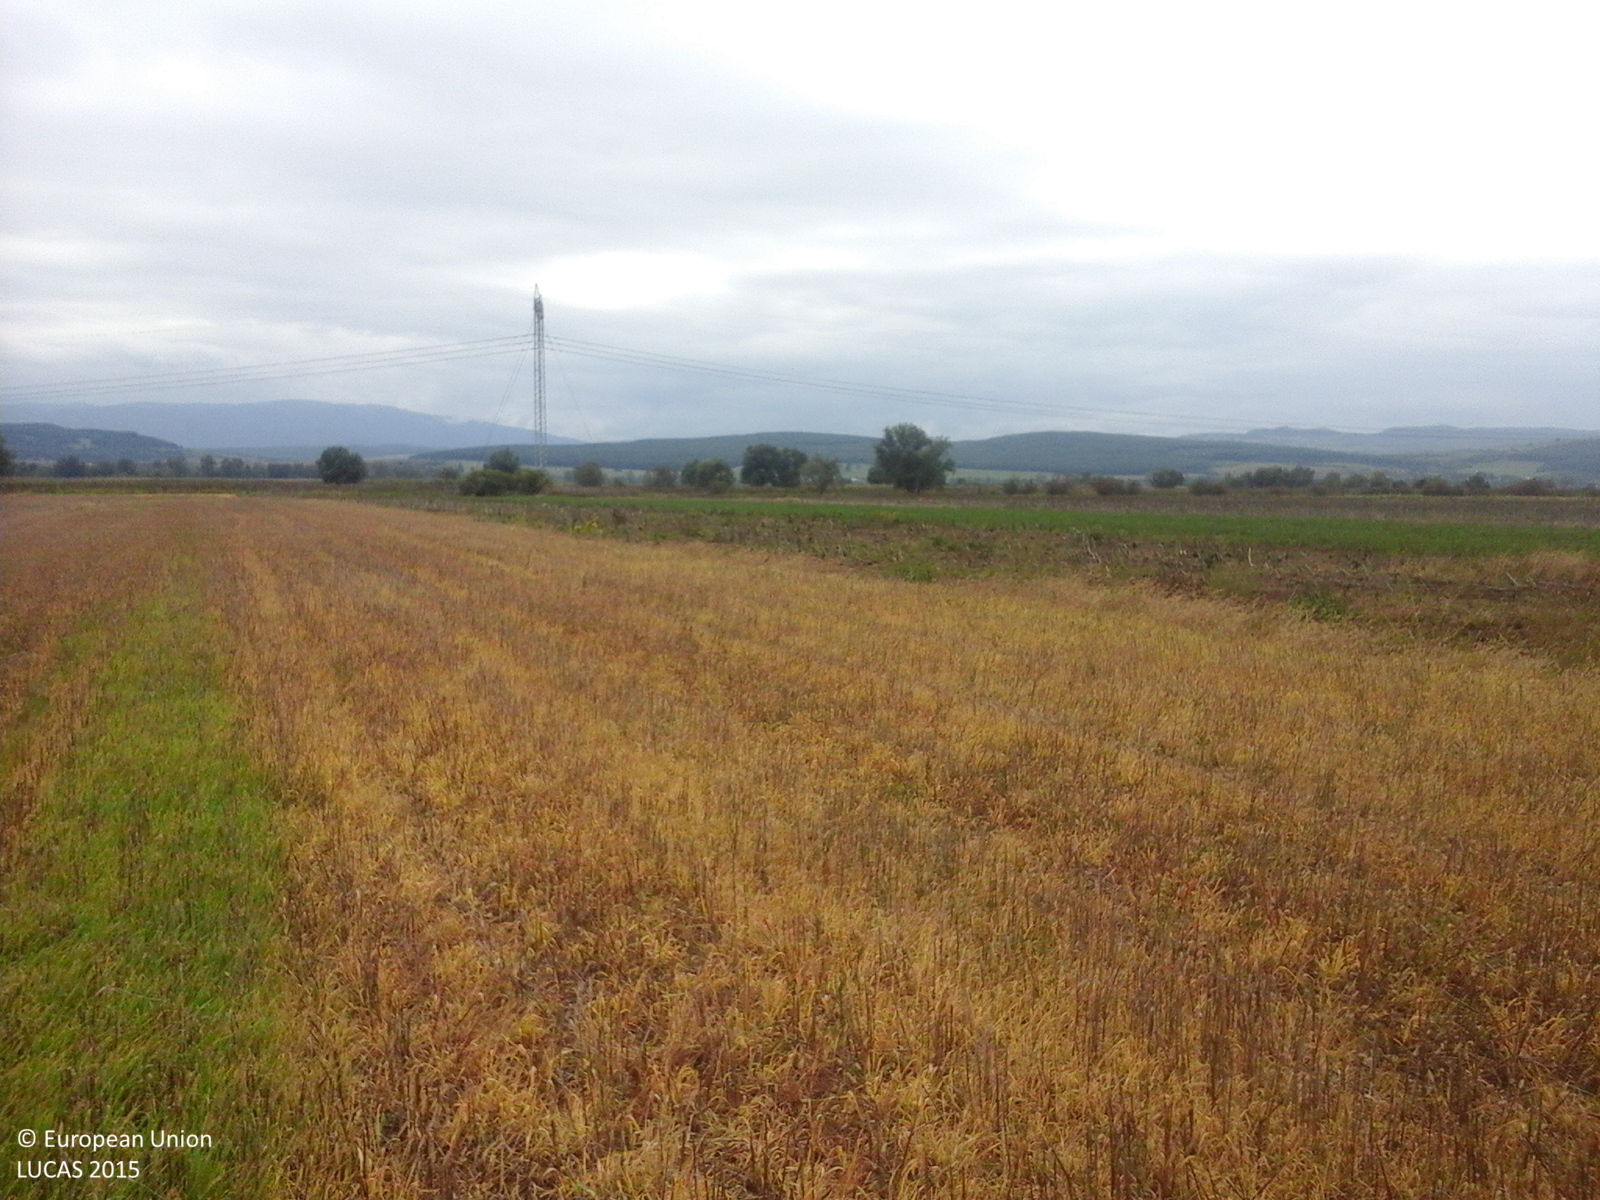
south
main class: Cropland
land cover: Common wheat
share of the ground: > 75 %
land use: Agriculture (excluding fallow land and kitchen gardens)
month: September
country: RO
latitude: 45.8689
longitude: 23.1065
